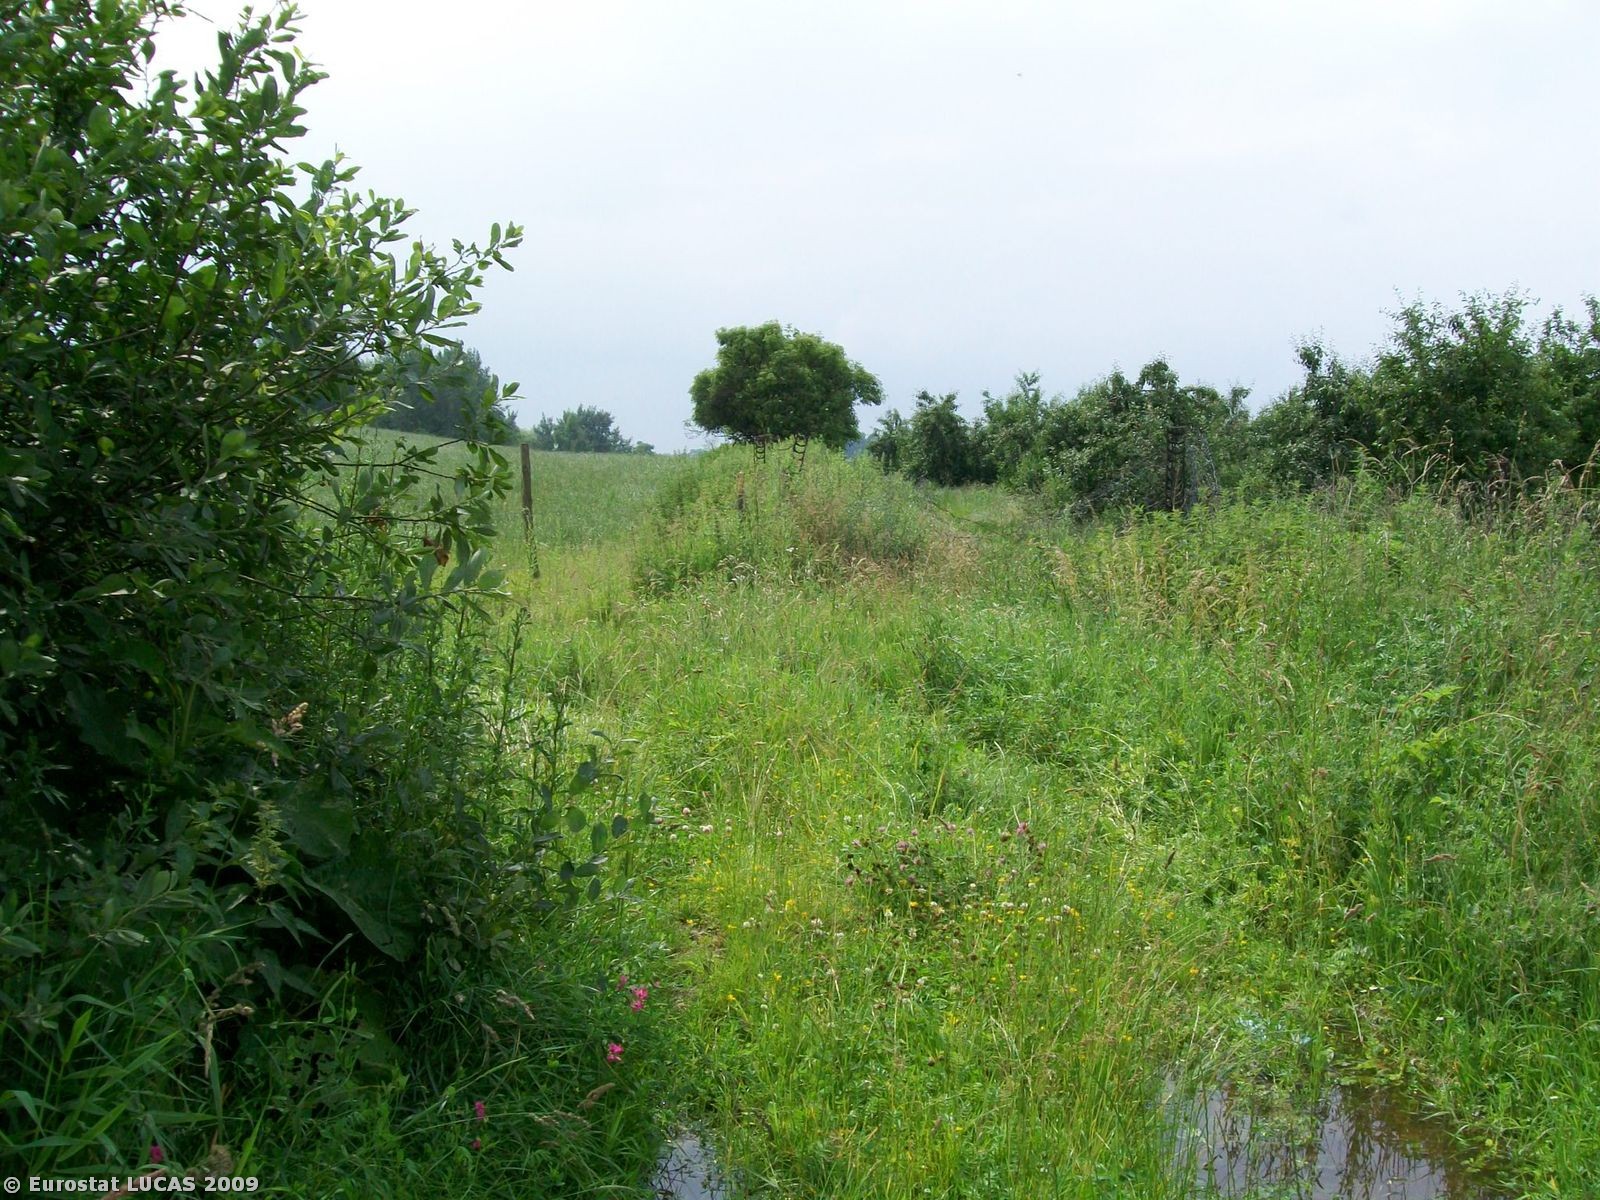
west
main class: Cropland
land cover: Apple fruit
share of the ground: 50 - 75 %
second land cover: Grassland with sparse tree/shrub cover
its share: > 75 %
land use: Agriculture (excluding fallow land and kitchen gardens)
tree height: < 5 m
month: June
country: PL
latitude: 51.2295
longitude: 16.0925
